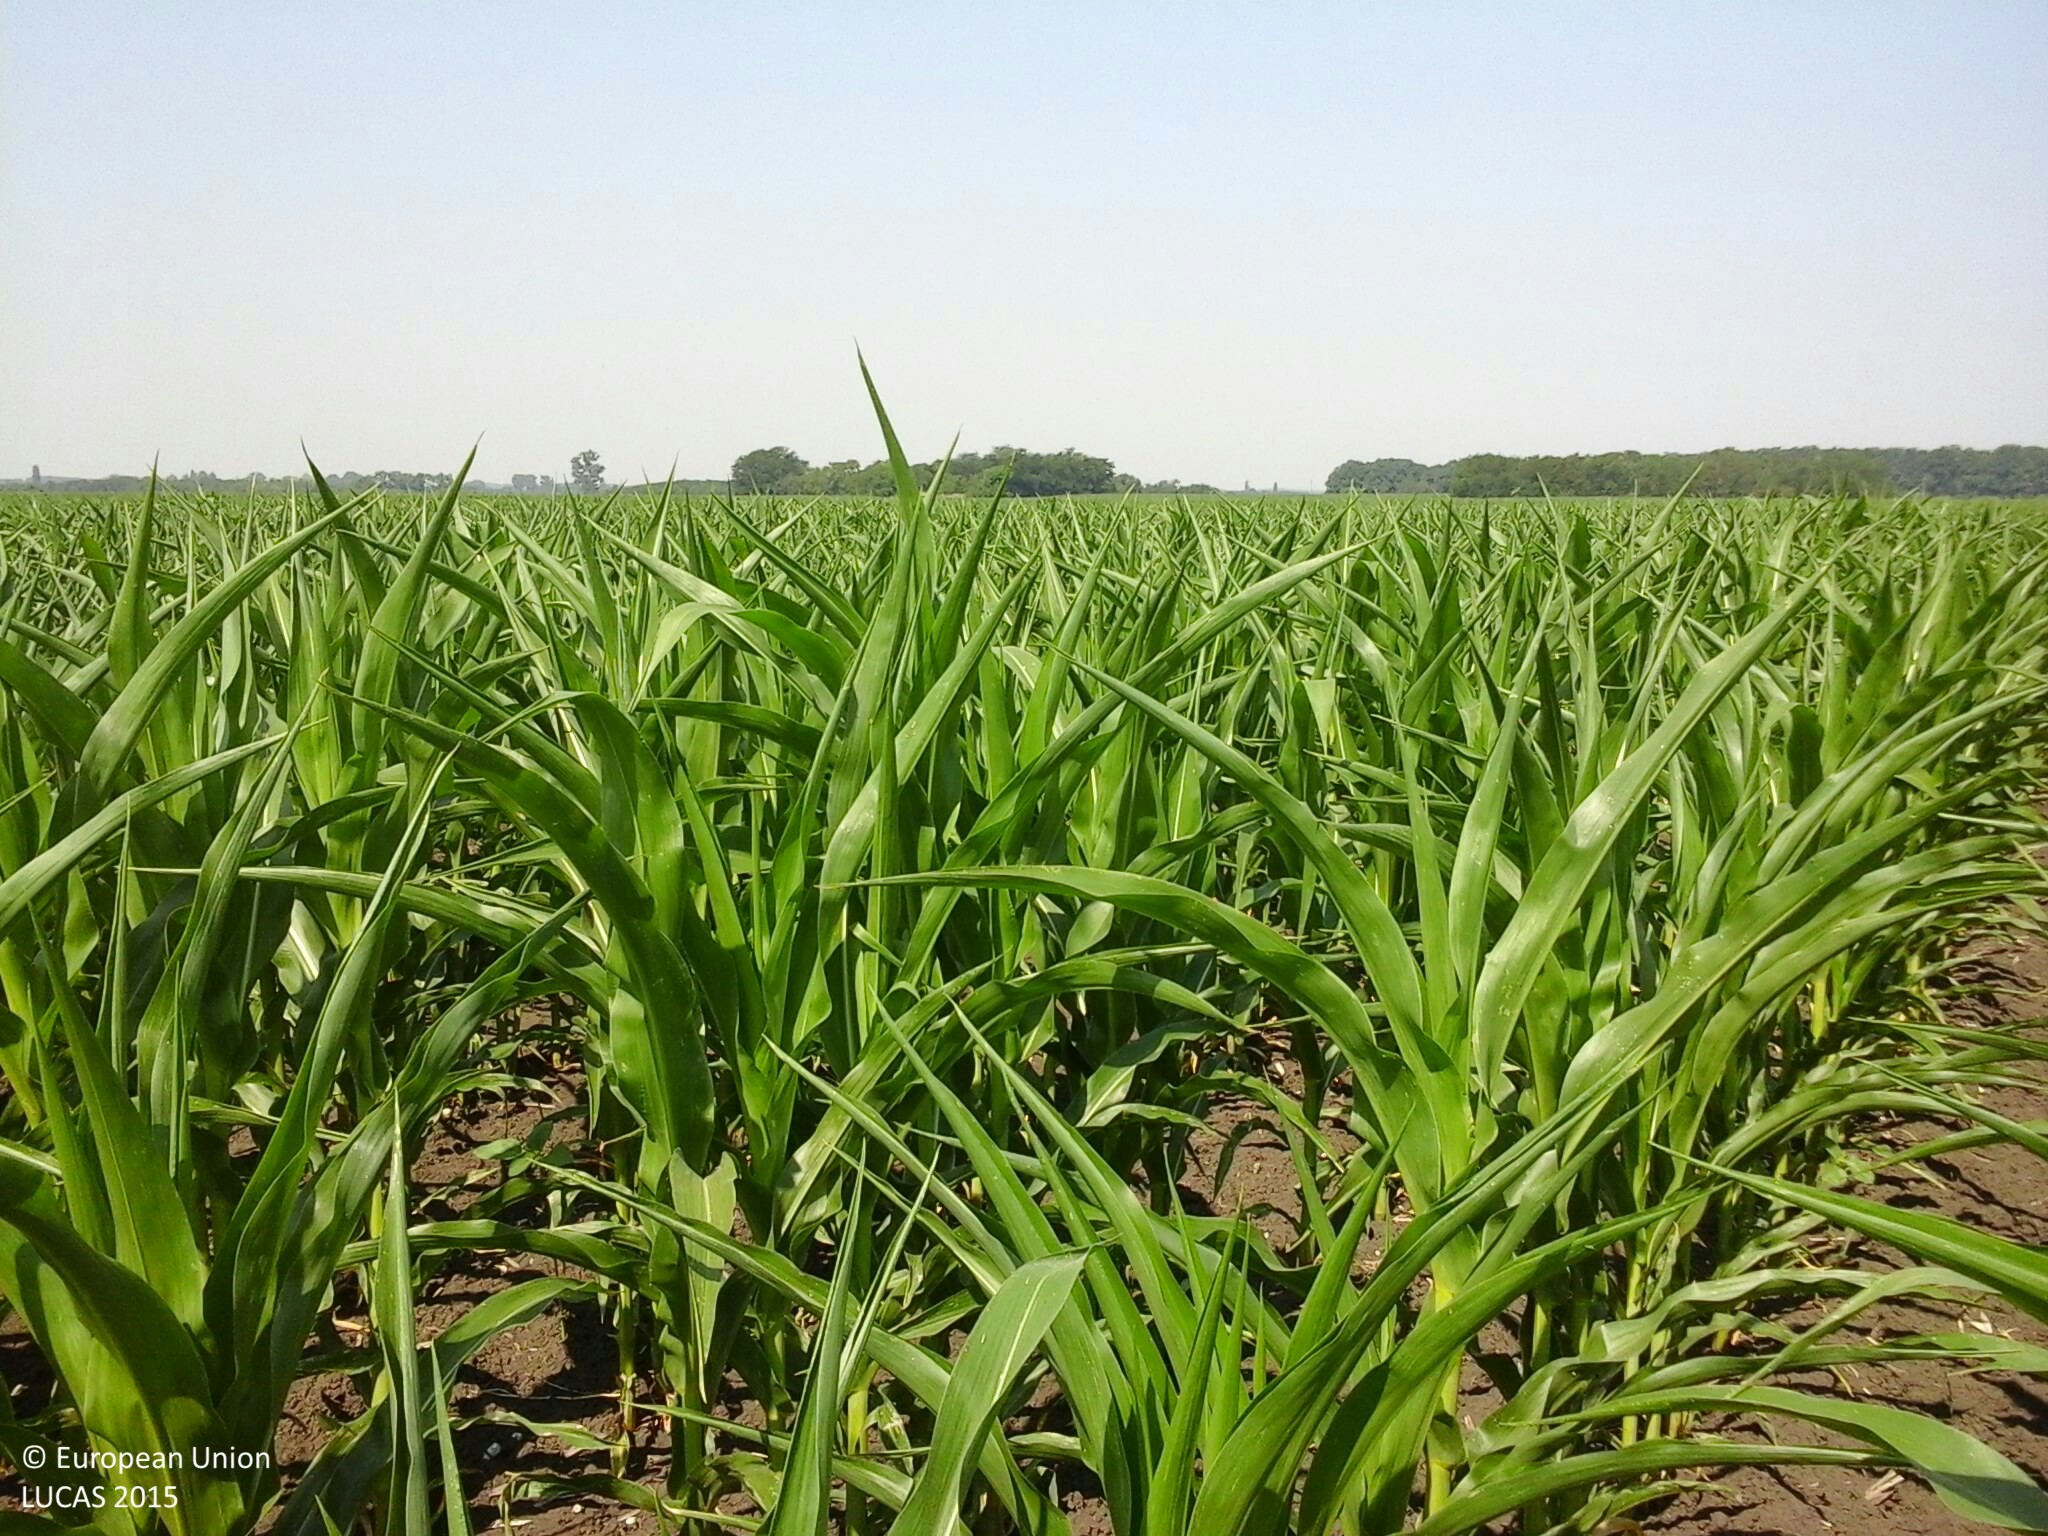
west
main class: Cropland
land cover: Maize
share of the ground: > 75 %
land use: Agriculture (excluding fallow land and kitchen gardens)
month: July
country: HU
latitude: 46.7722
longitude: 20.1737
